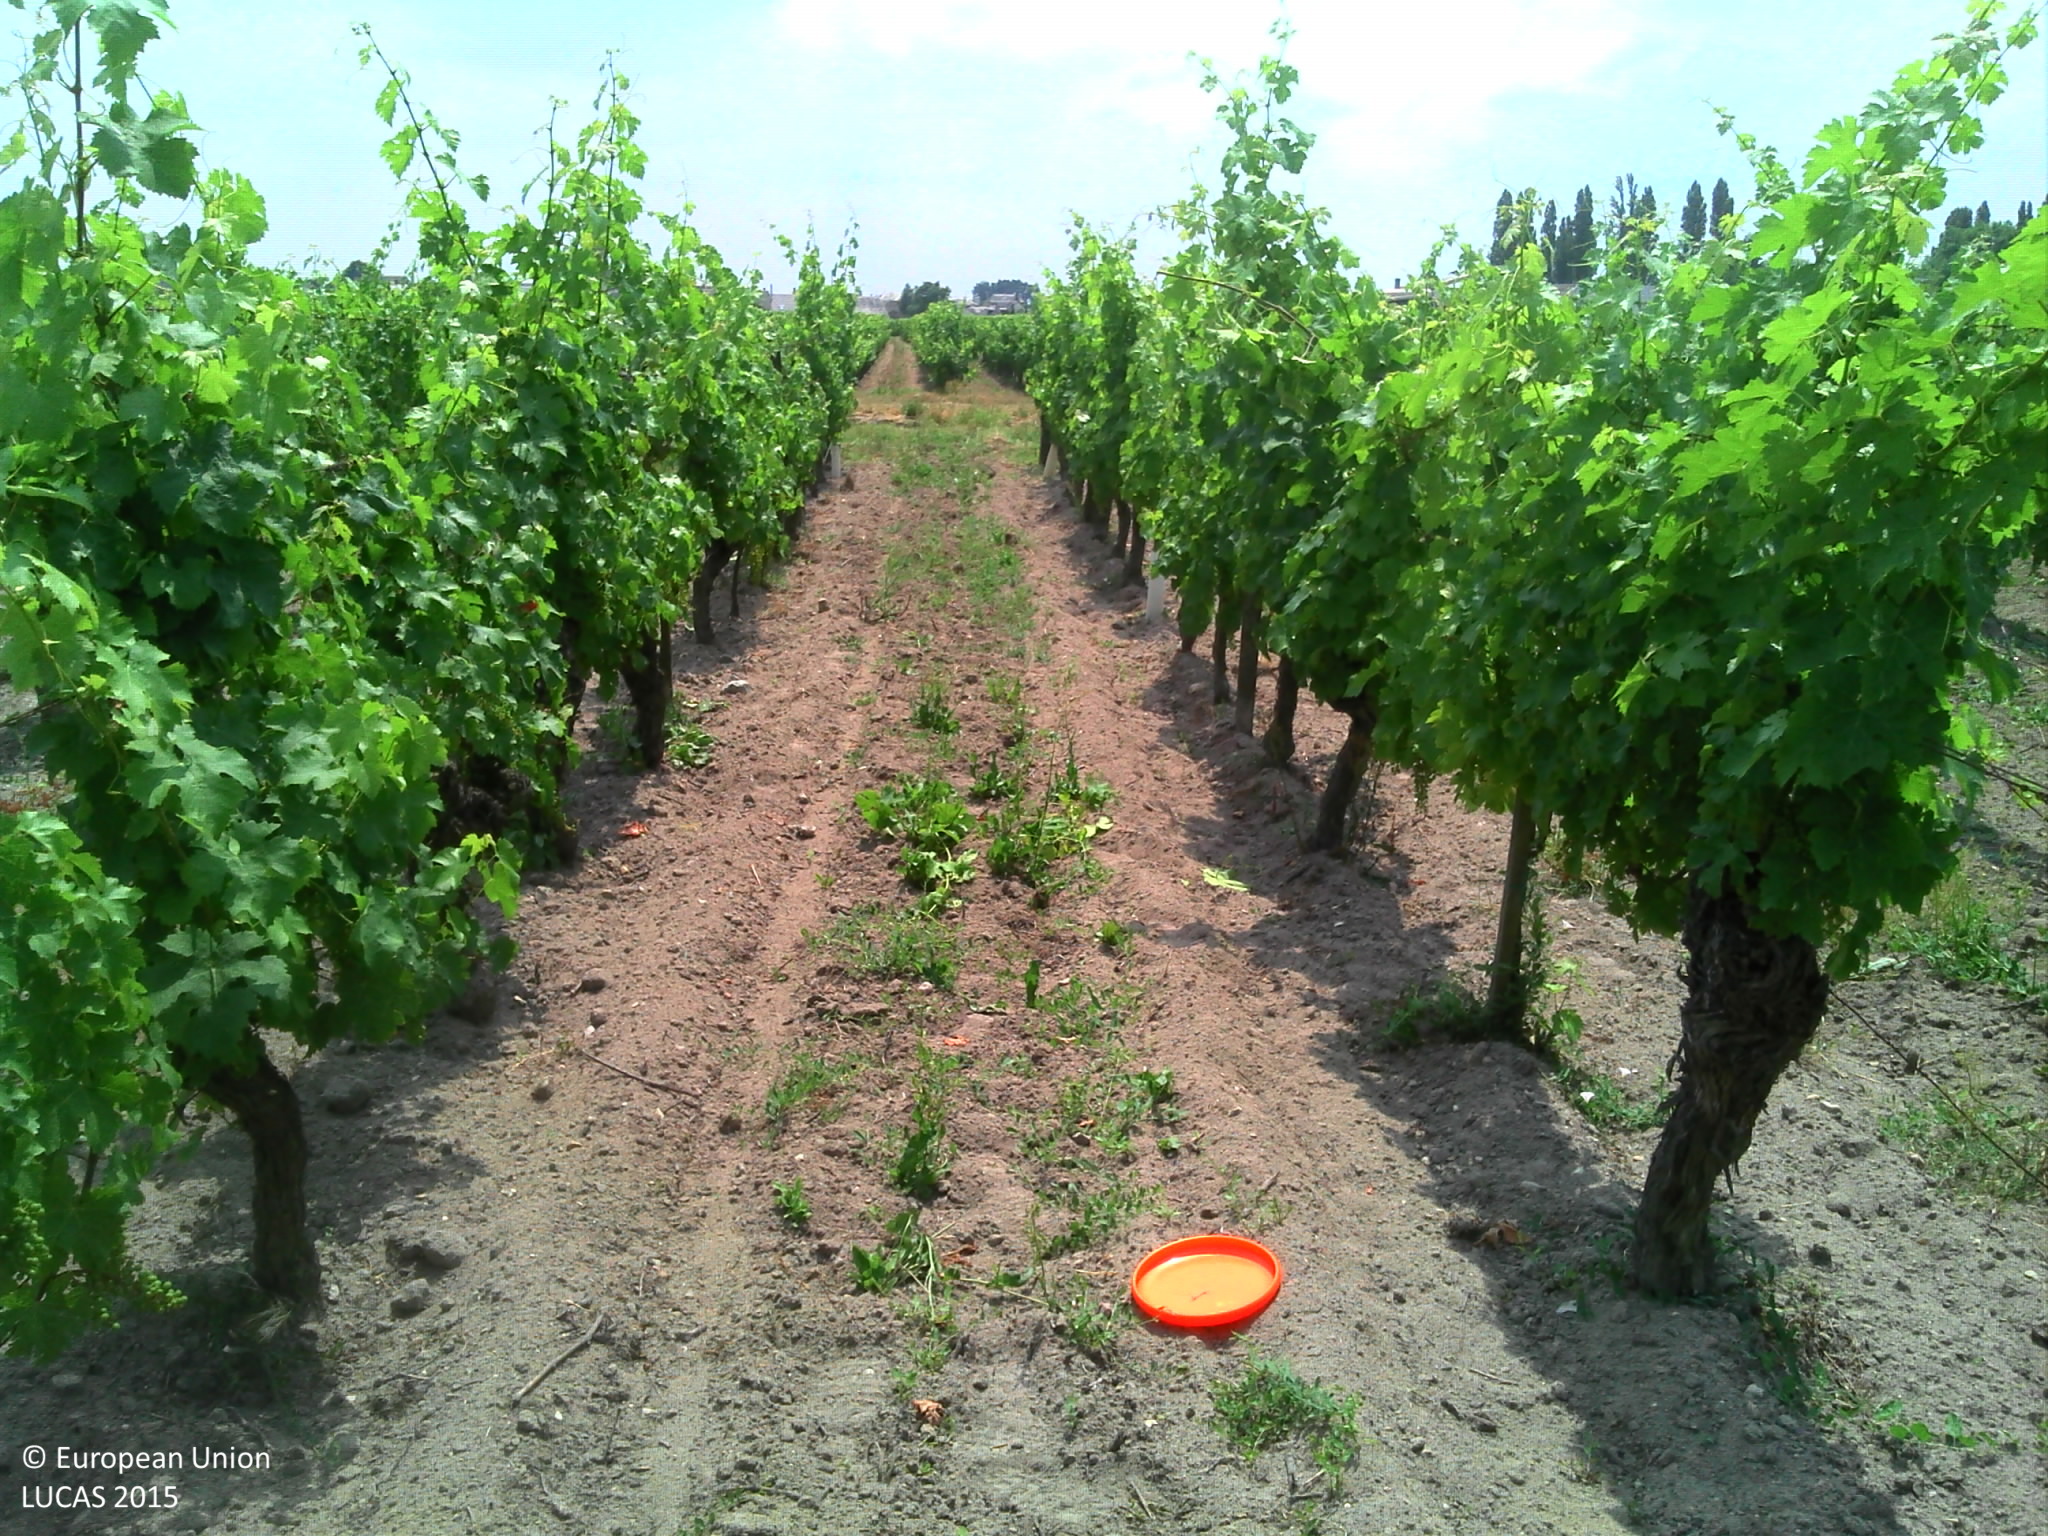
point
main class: Cropland
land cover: Vineyards
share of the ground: 25 - 50 %
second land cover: Other bare soil
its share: > 75 %
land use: Agriculture (excluding fallow land and kitchen gardens)
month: July
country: FR
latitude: 47.2897
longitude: 0.1252
